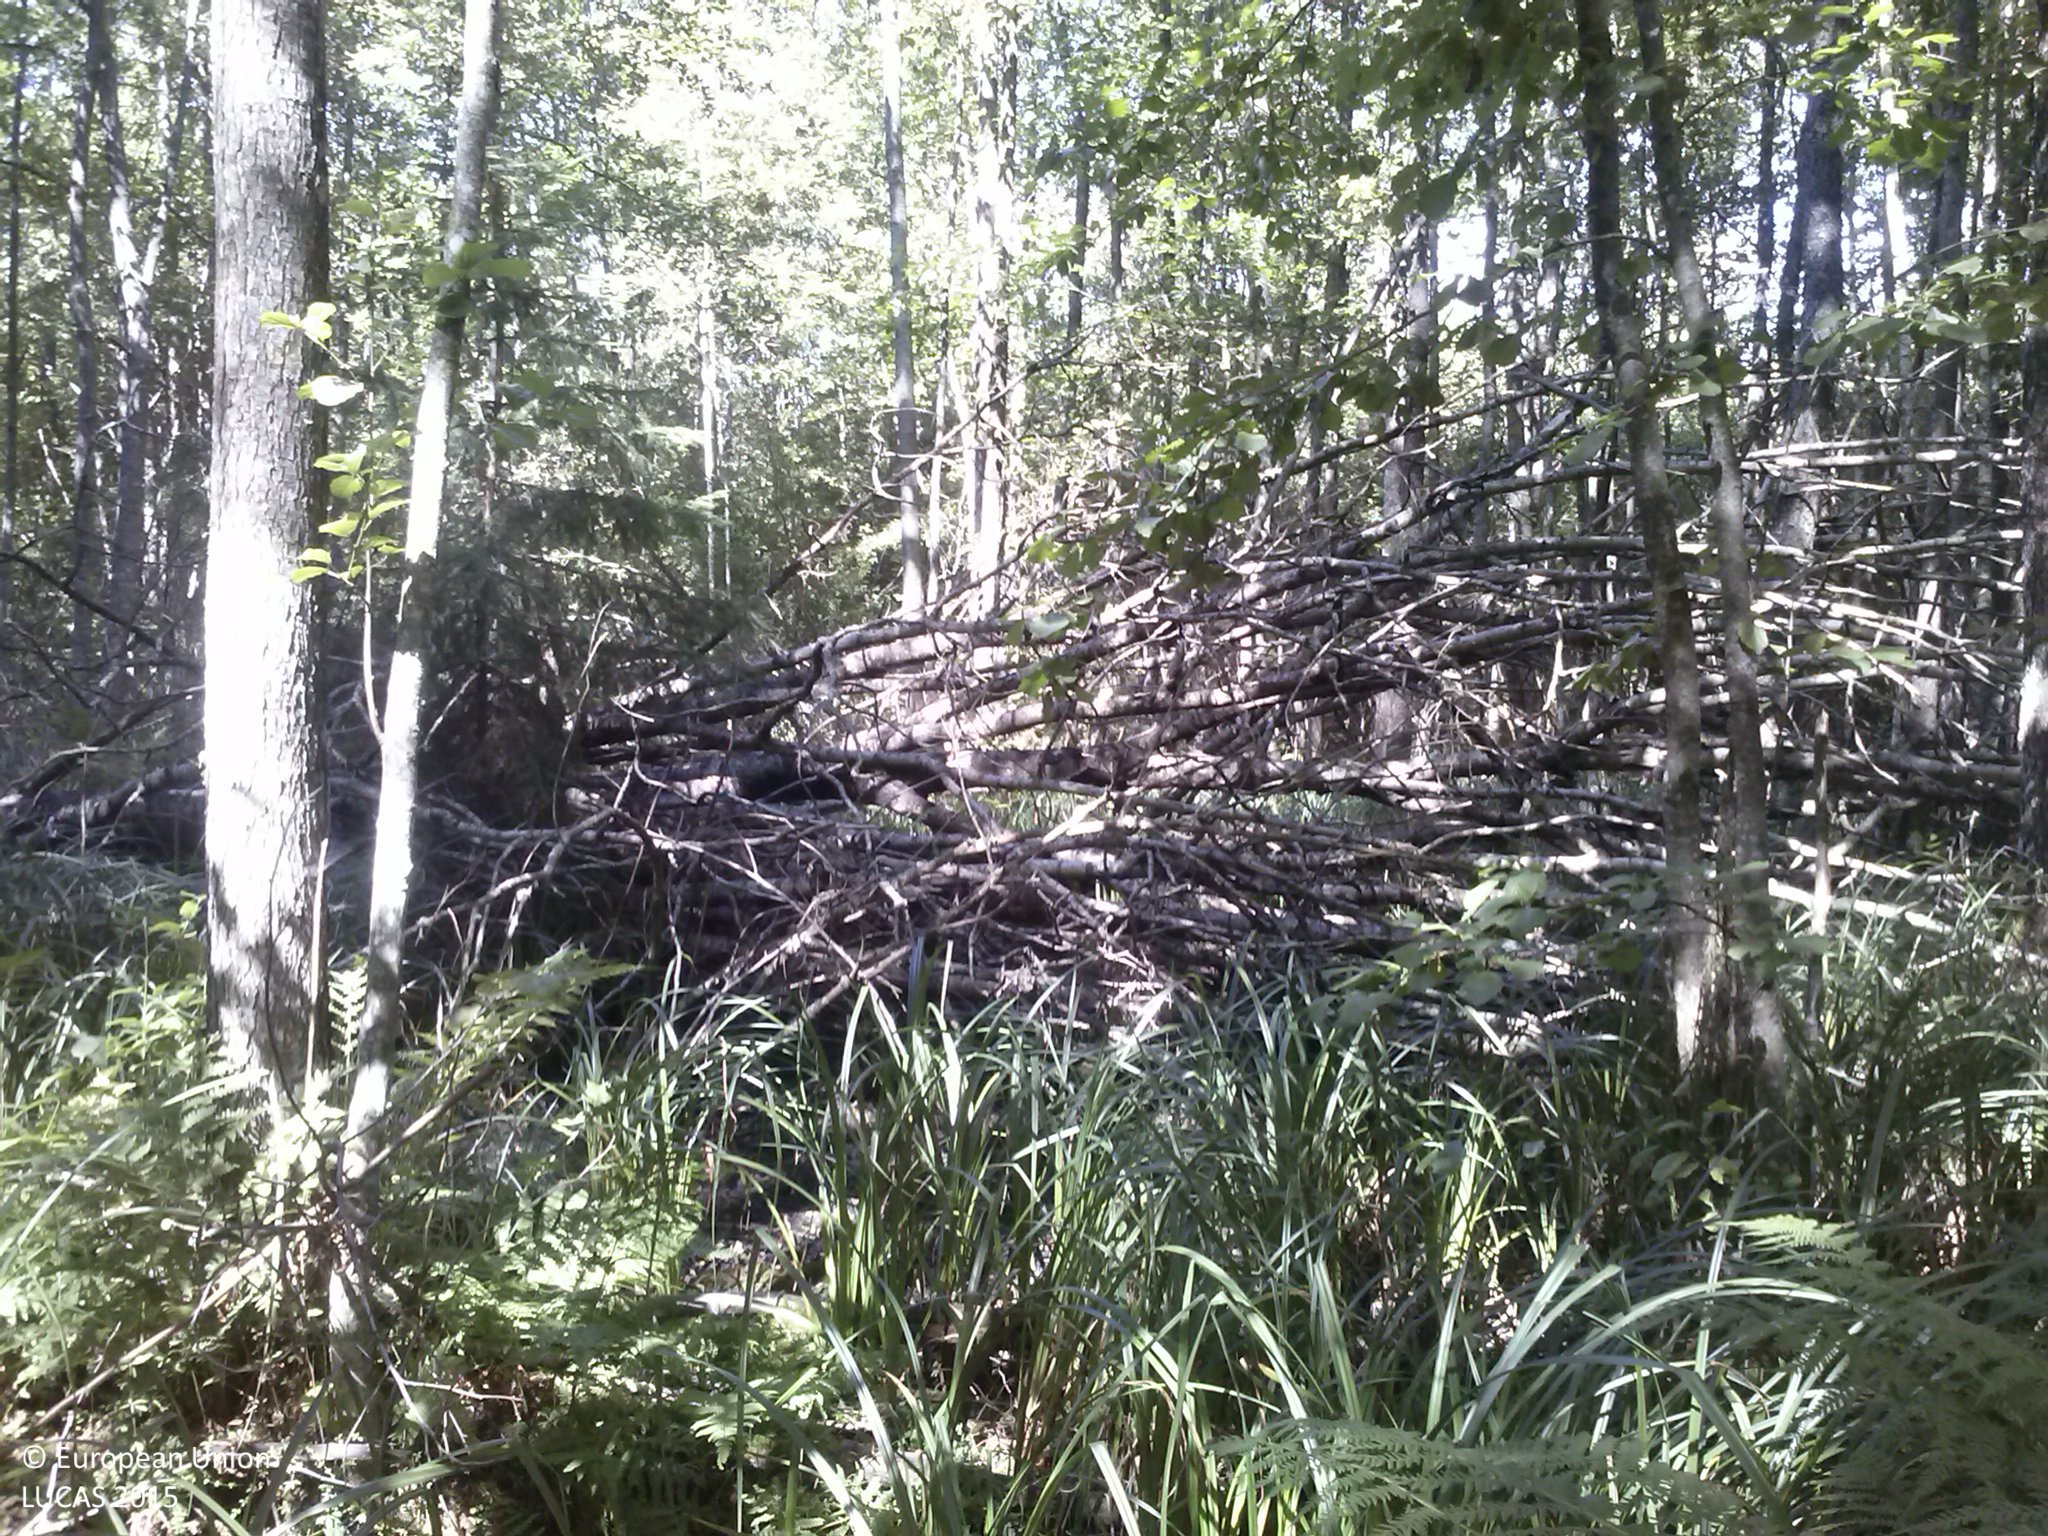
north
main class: Woodland
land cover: Broadleaved woodland
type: non-riverine alder, birch or aspen forest
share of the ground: > 75 %
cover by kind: broadleaved forest trees 75 %, herbaceous plants 25 %
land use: Forestry
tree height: > 5 m
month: August
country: LV
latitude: 56.1998
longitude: 26.8751
